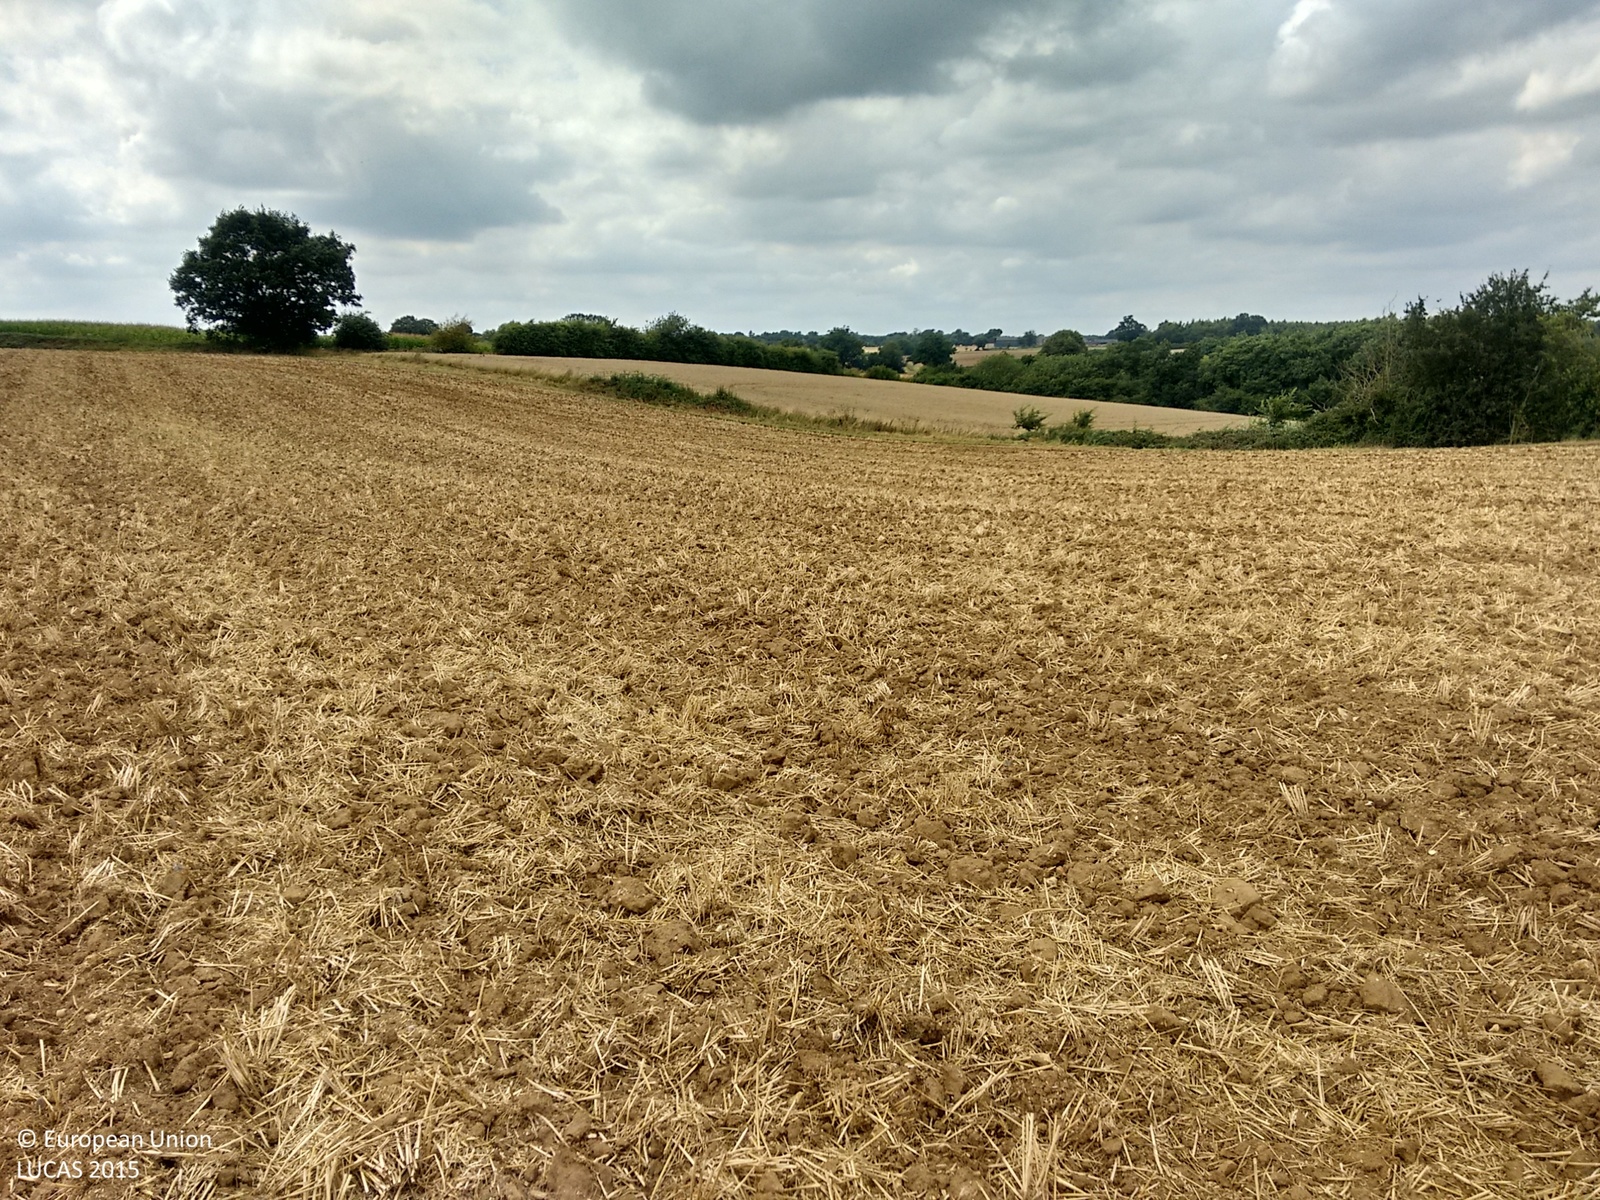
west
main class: Cropland
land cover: Common wheat
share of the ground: 25 - 50 %
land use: Agriculture (excluding fallow land and kitchen gardens)
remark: Harvested field
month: August
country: GB
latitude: 52.0471
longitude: 0.9212
